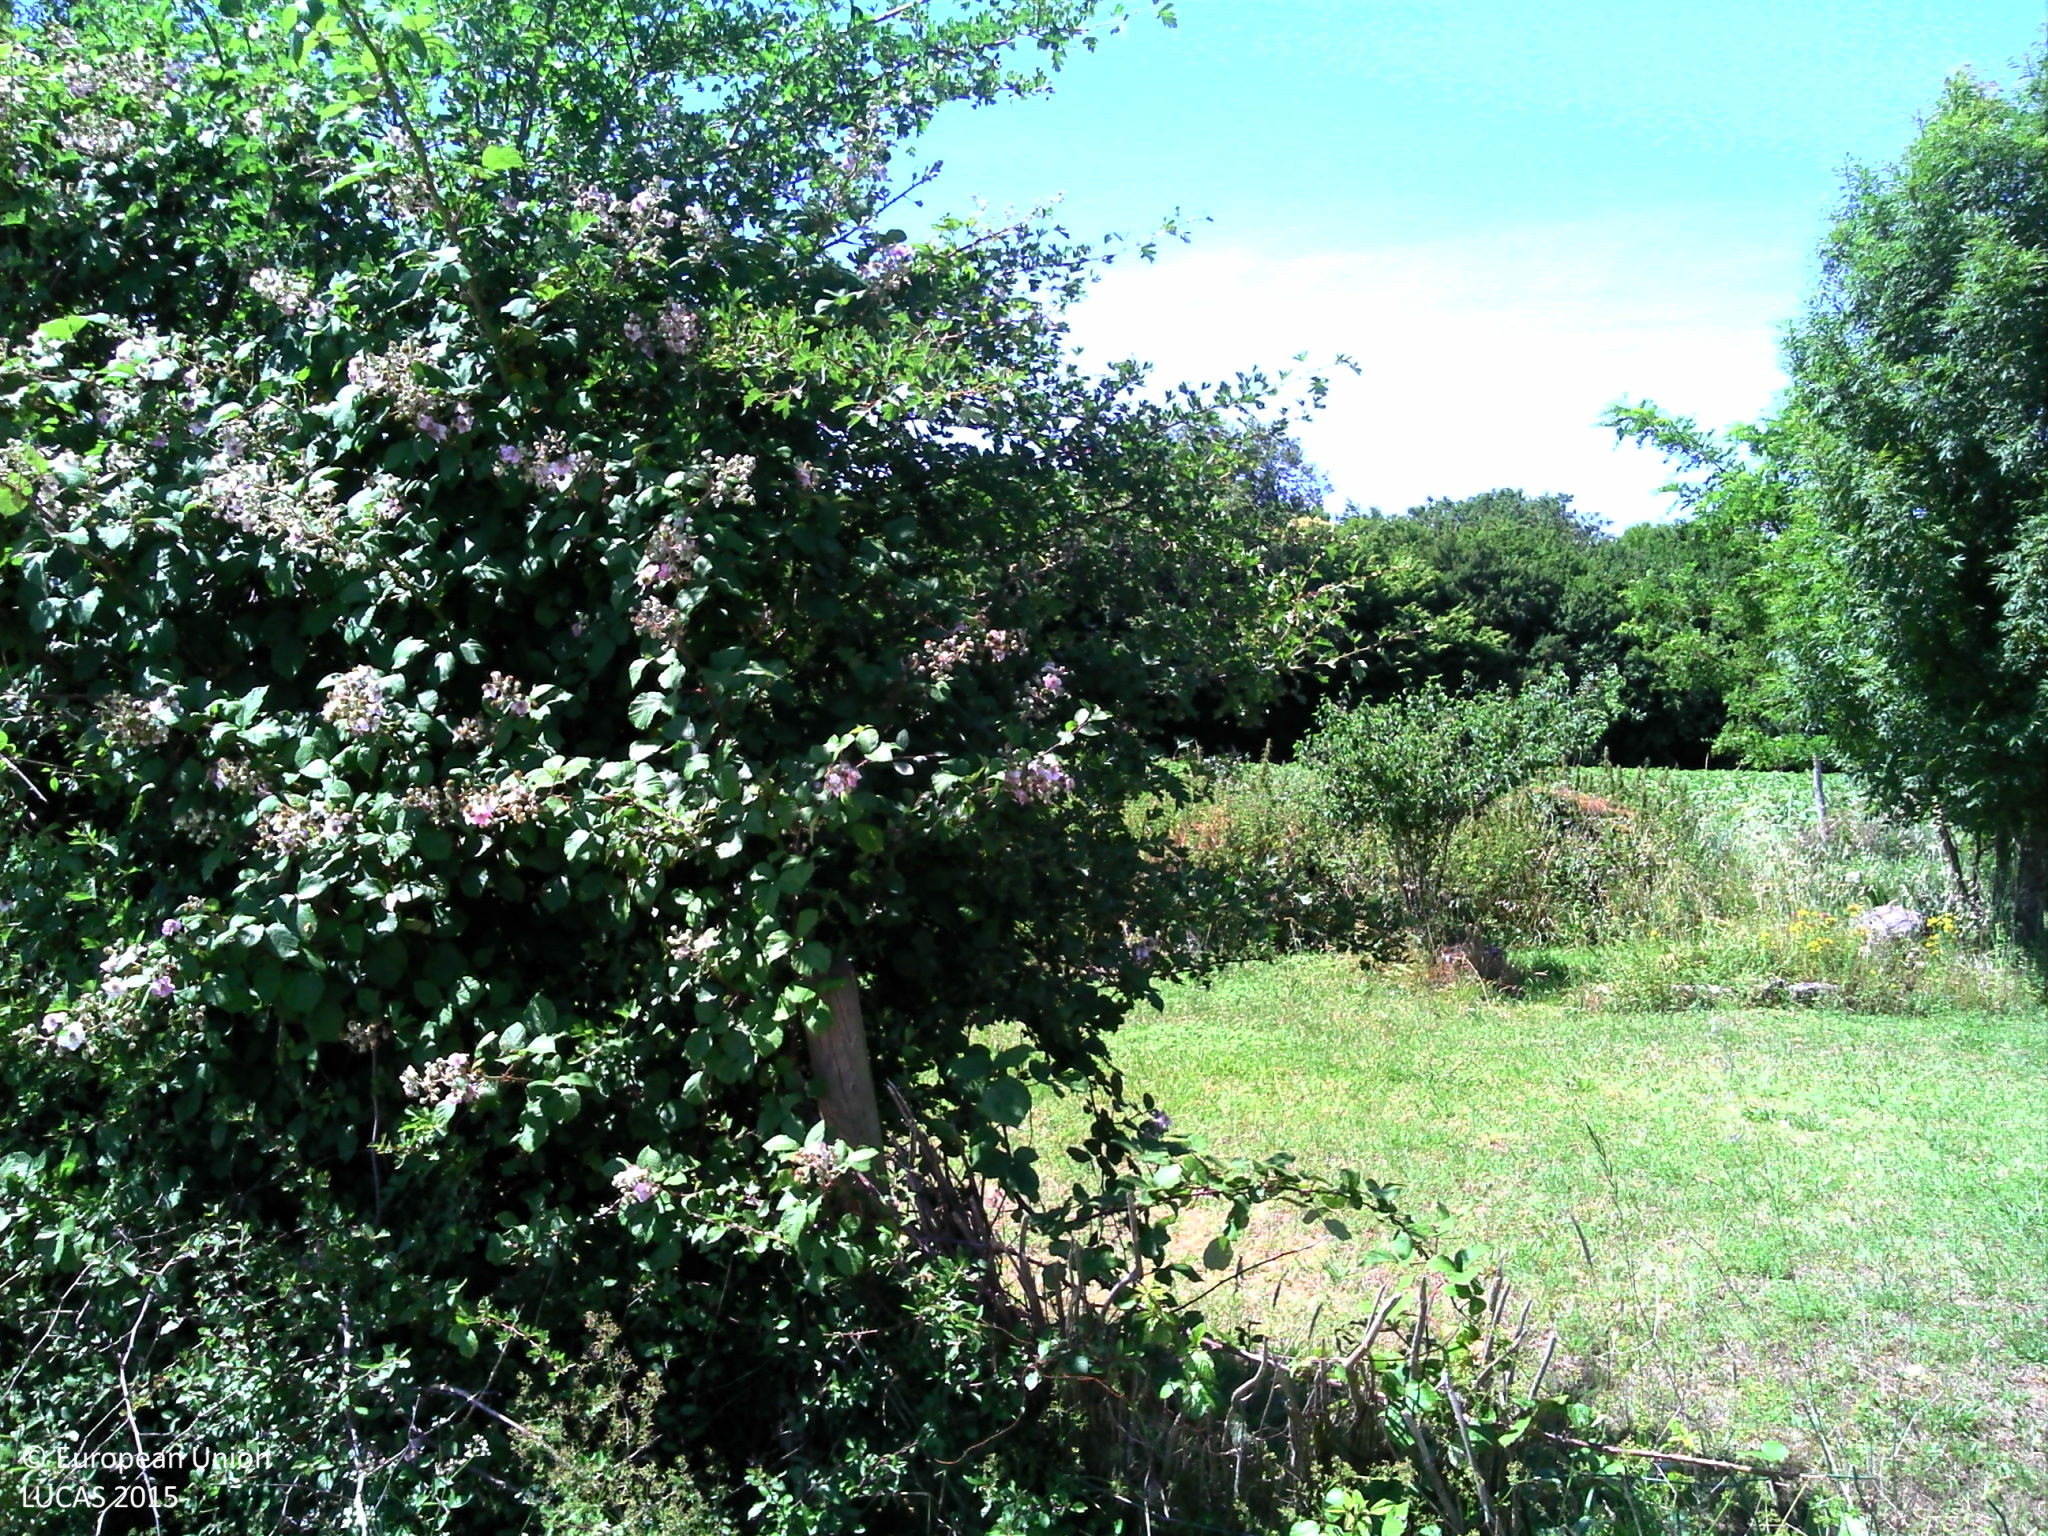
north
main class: Grassland
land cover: Grassland with sparse tree/shrub cover
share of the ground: > 75 %
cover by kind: herbaceous plants 95 %, coniferous forest trees 5 %
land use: Residential
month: June
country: FR
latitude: 45.8161
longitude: -0.6682
